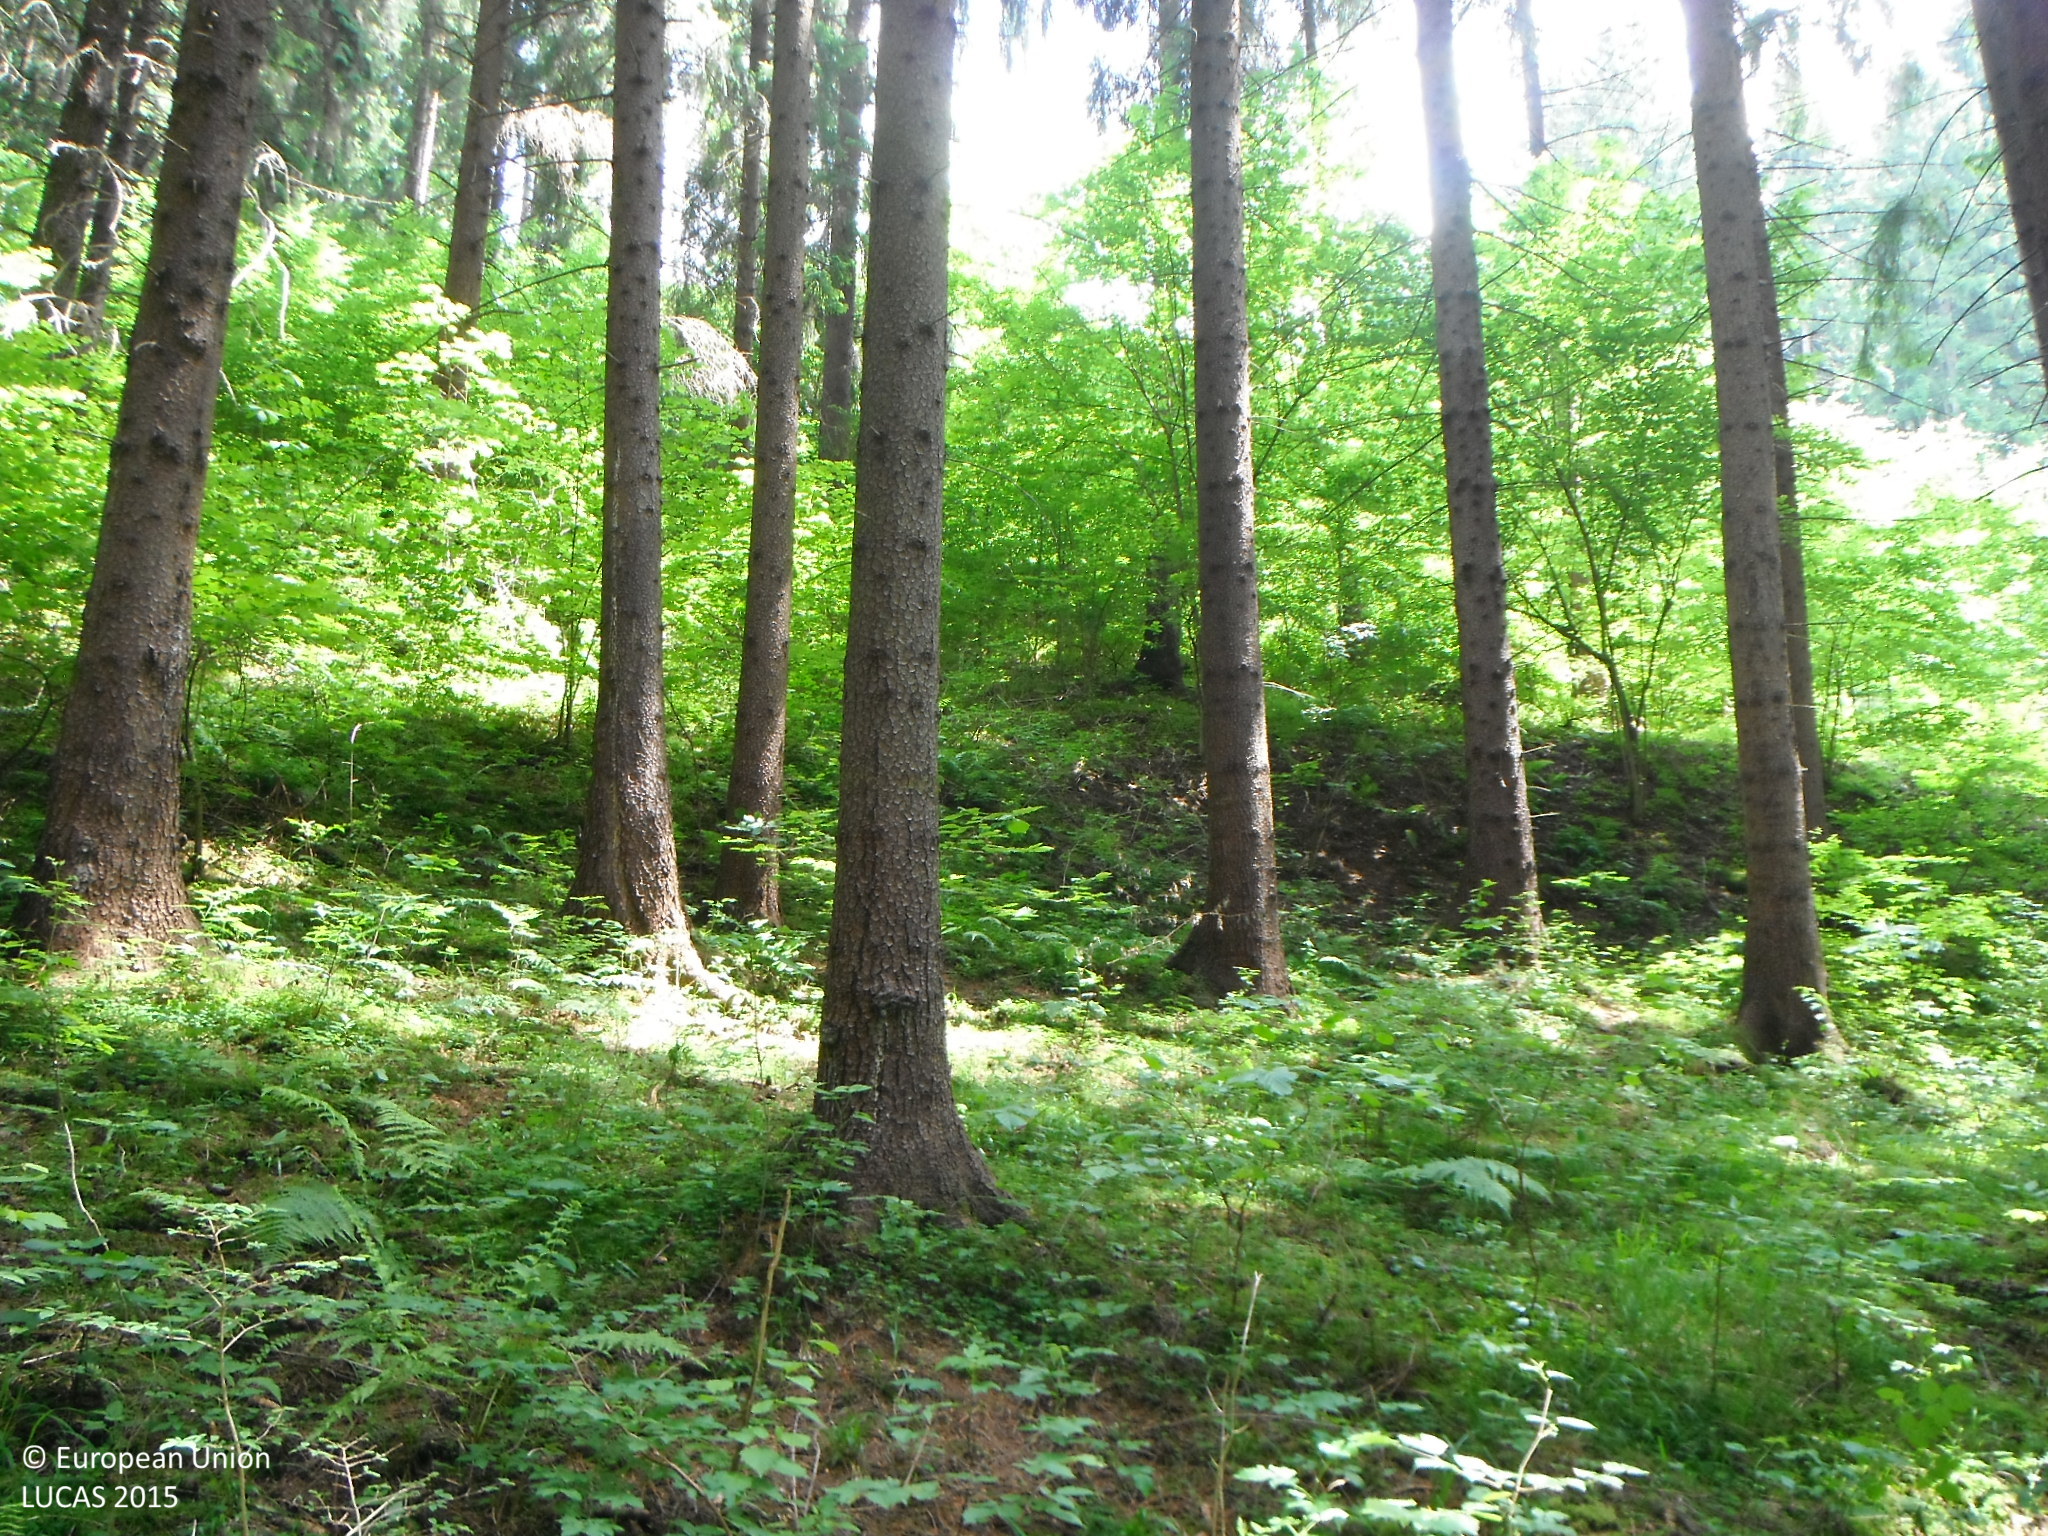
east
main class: Woodland
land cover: Spruce dominated coniferous woodland
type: alpine coniferous forest
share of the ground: > 75 %
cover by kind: coniferous forest trees 90 %, herbaceous plants 10 %
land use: Forestry
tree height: > 5 m
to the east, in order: Spruce dominated coniferous woodland; Spontaneously vegetated surfaces; Spruce dominated coniferous woodland; Spruce dominated mixed woodland; Tracks; Shrubland with sparse tree cover; Tracks; Spruce dominated coniferous woodland
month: June
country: SK
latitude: 49.1890
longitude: 19.2860
